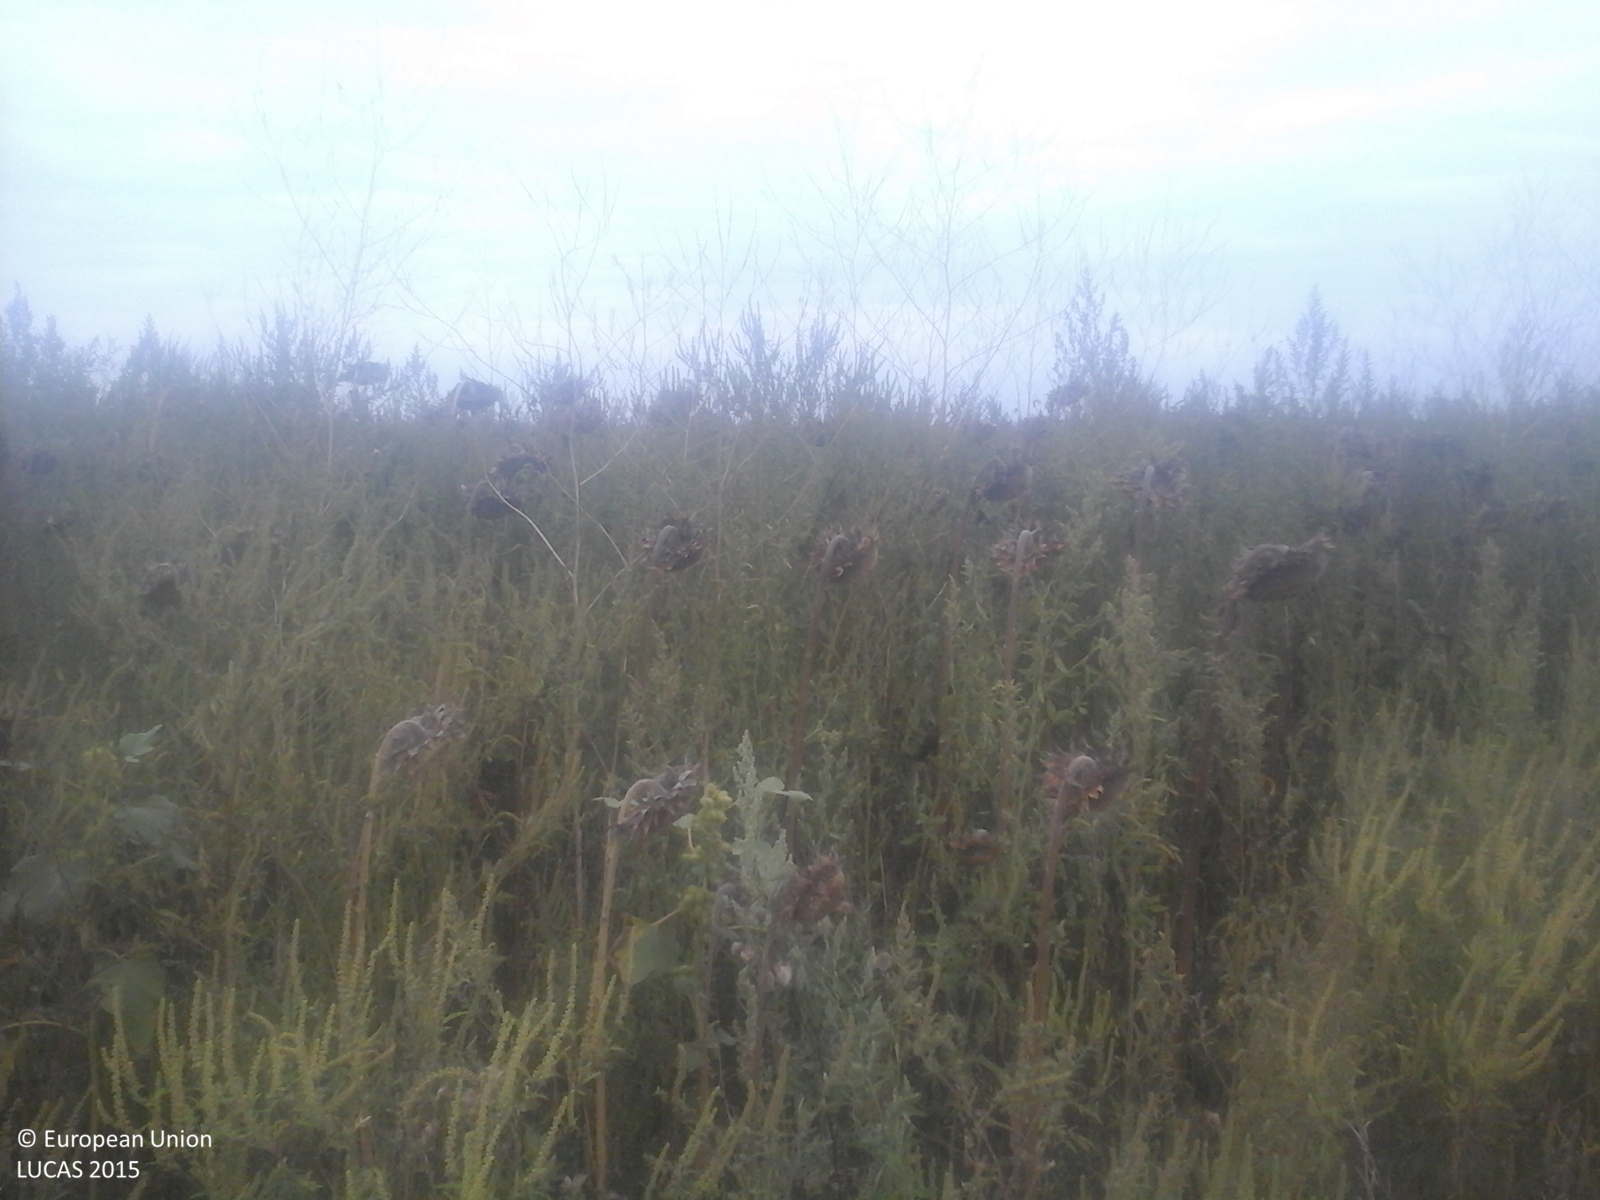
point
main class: Cropland
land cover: Sunflower
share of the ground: > 75 %
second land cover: Spontaneously vegetated surfaces
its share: > 75 %
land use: Agriculture (excluding fallow land and kitchen gardens)
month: September
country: RO
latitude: 47.7415
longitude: 22.6908
